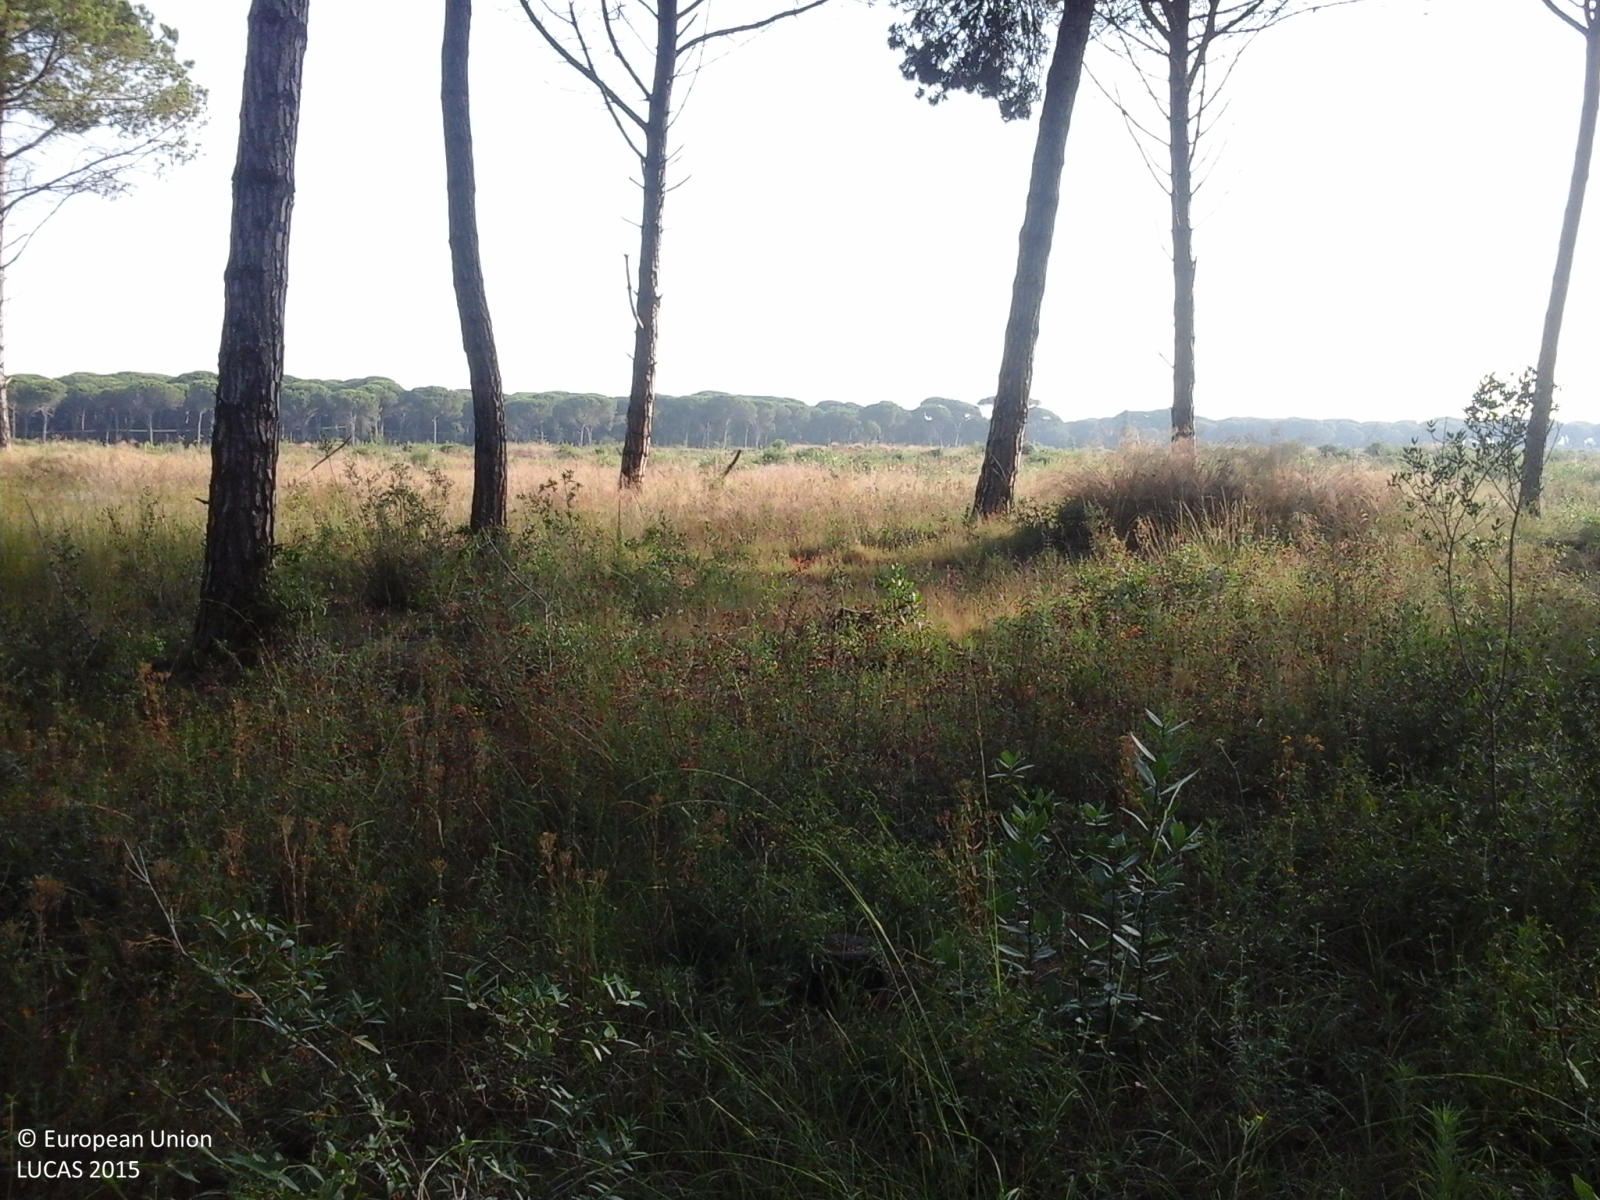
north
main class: Woodland
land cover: Pine dominated coniferous woodland
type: broadleaved evergreen forest
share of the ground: > 75 %
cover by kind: coniferous forest trees 80 %, shrubs 10 %, herbaceous plants 10 %
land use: Forestry
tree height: > 5 m
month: July
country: IT
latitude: 42.7215
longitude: 10.9859
